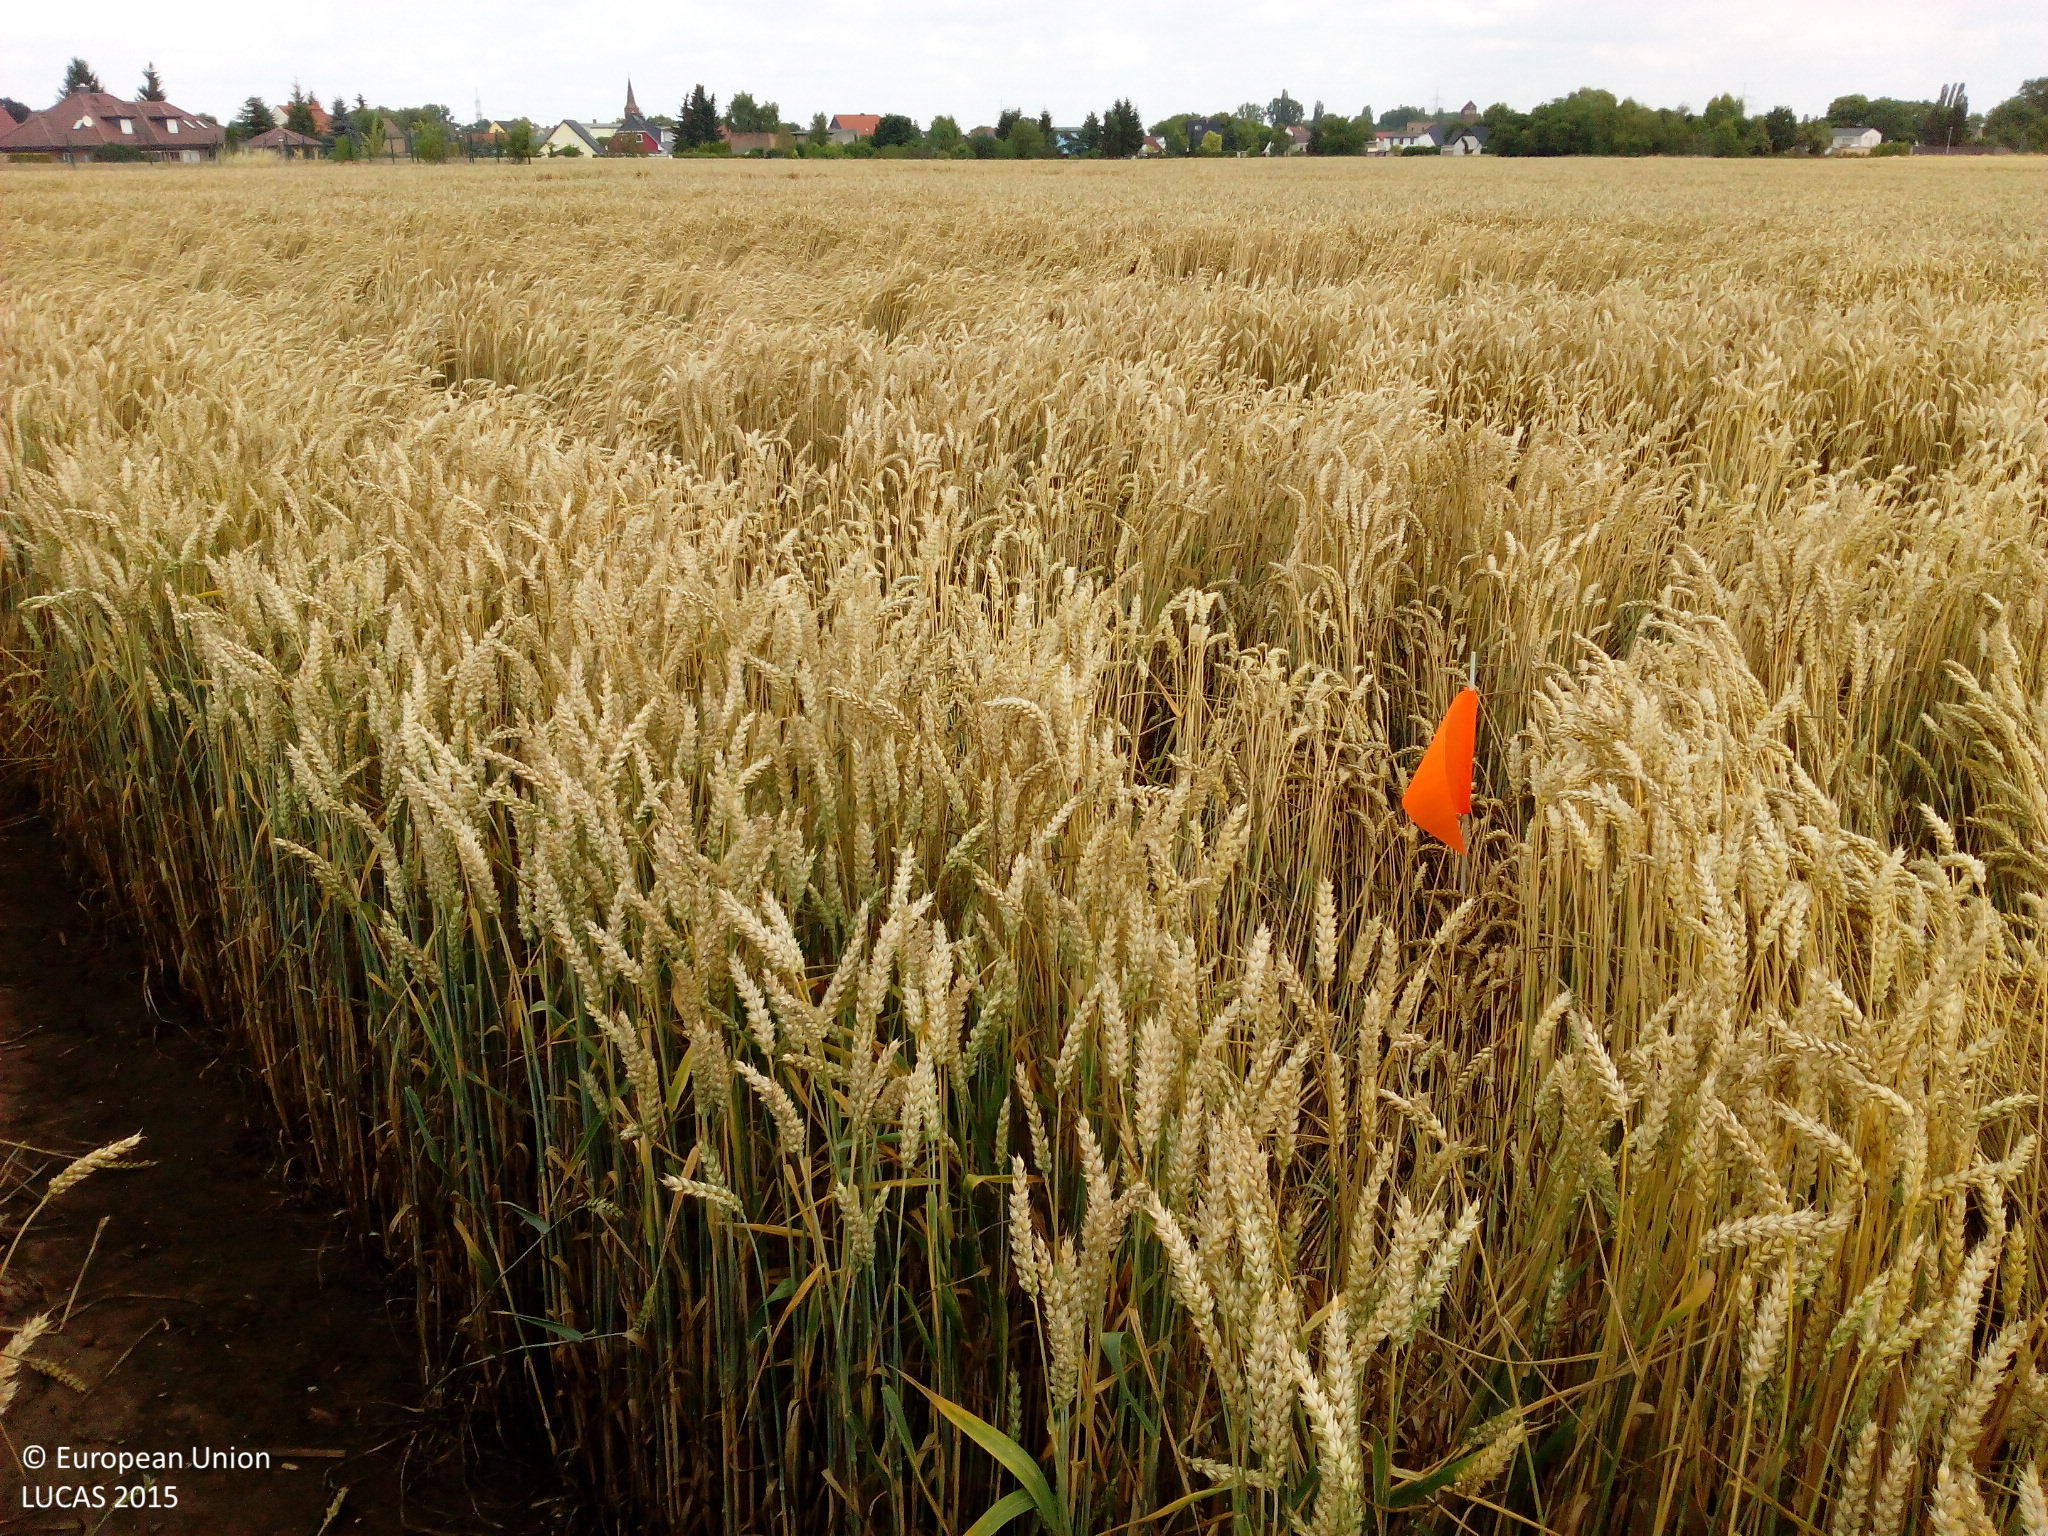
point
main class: Cropland
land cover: Common wheat
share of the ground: > 75 %
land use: Agriculture (excluding fallow land and kitchen gardens)
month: July
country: DE
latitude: 51.9518
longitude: 11.7020
